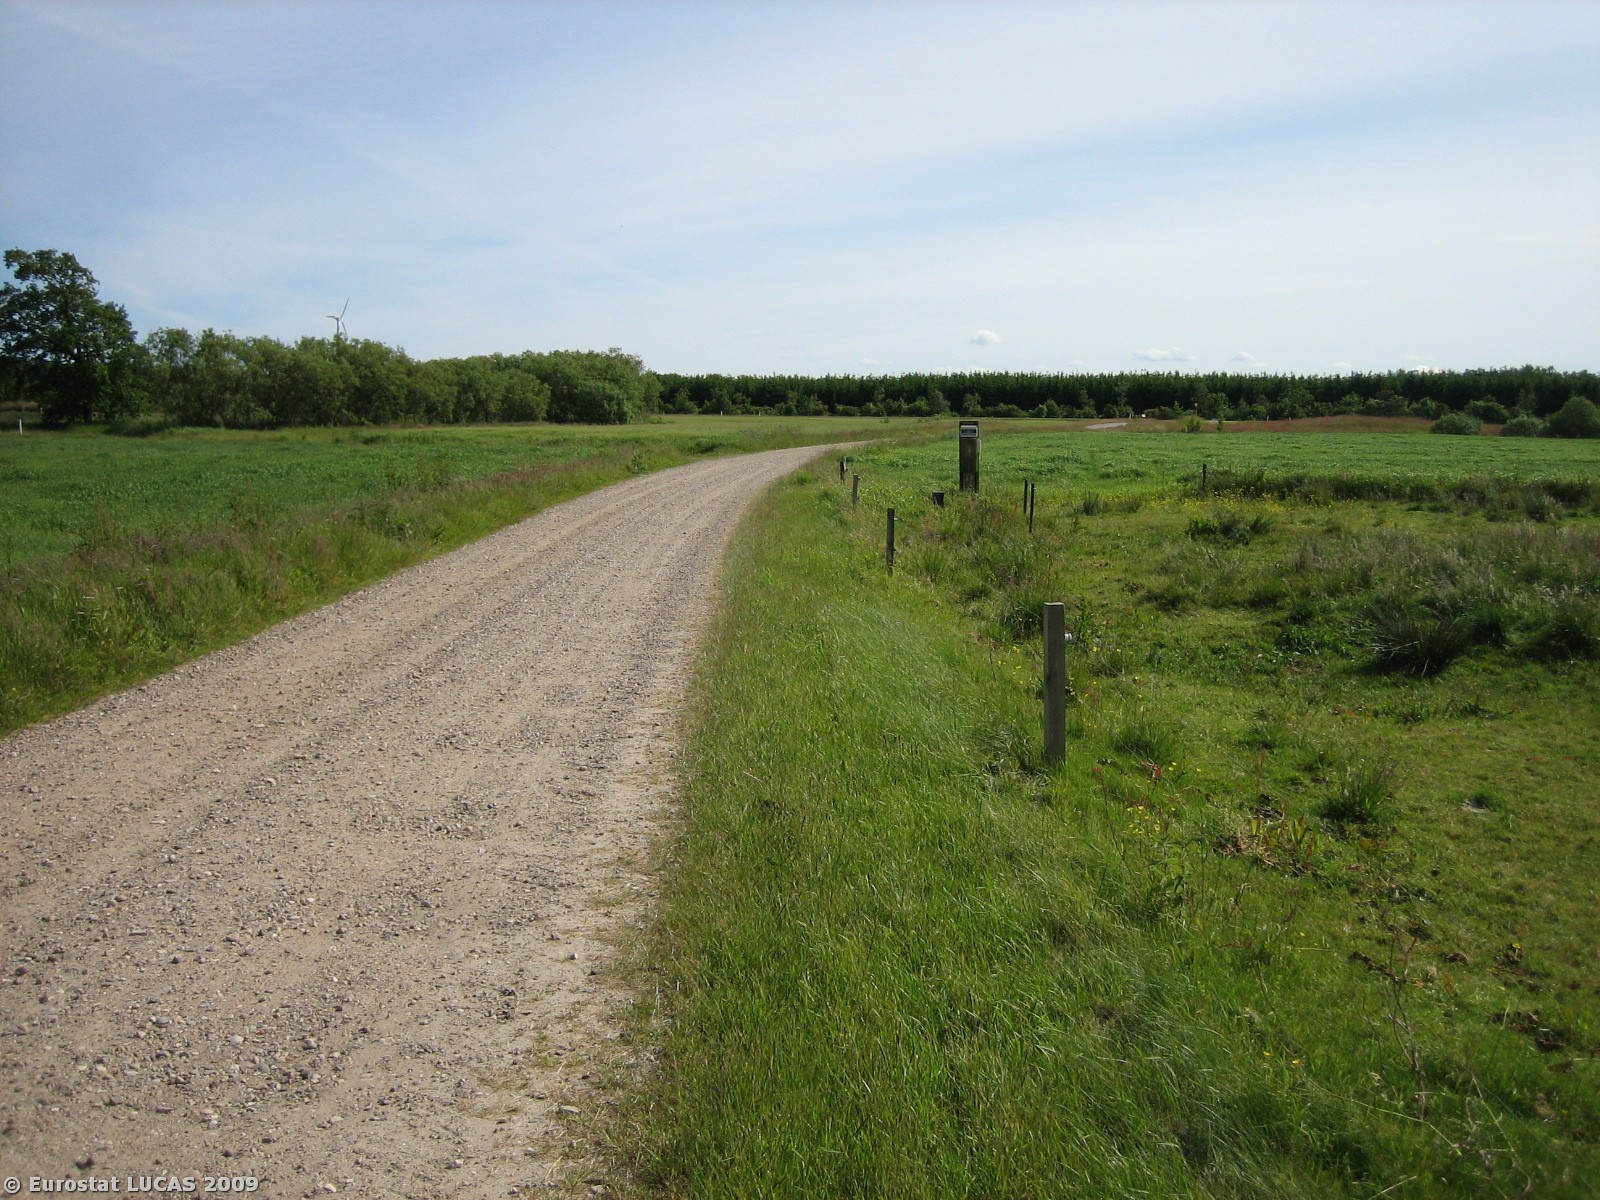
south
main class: Cropland
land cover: Common wheat
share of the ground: > 75 %
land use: Agriculture (excluding fallow land and kitchen gardens)
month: June
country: DK
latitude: 55.7545
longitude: 9.3156
